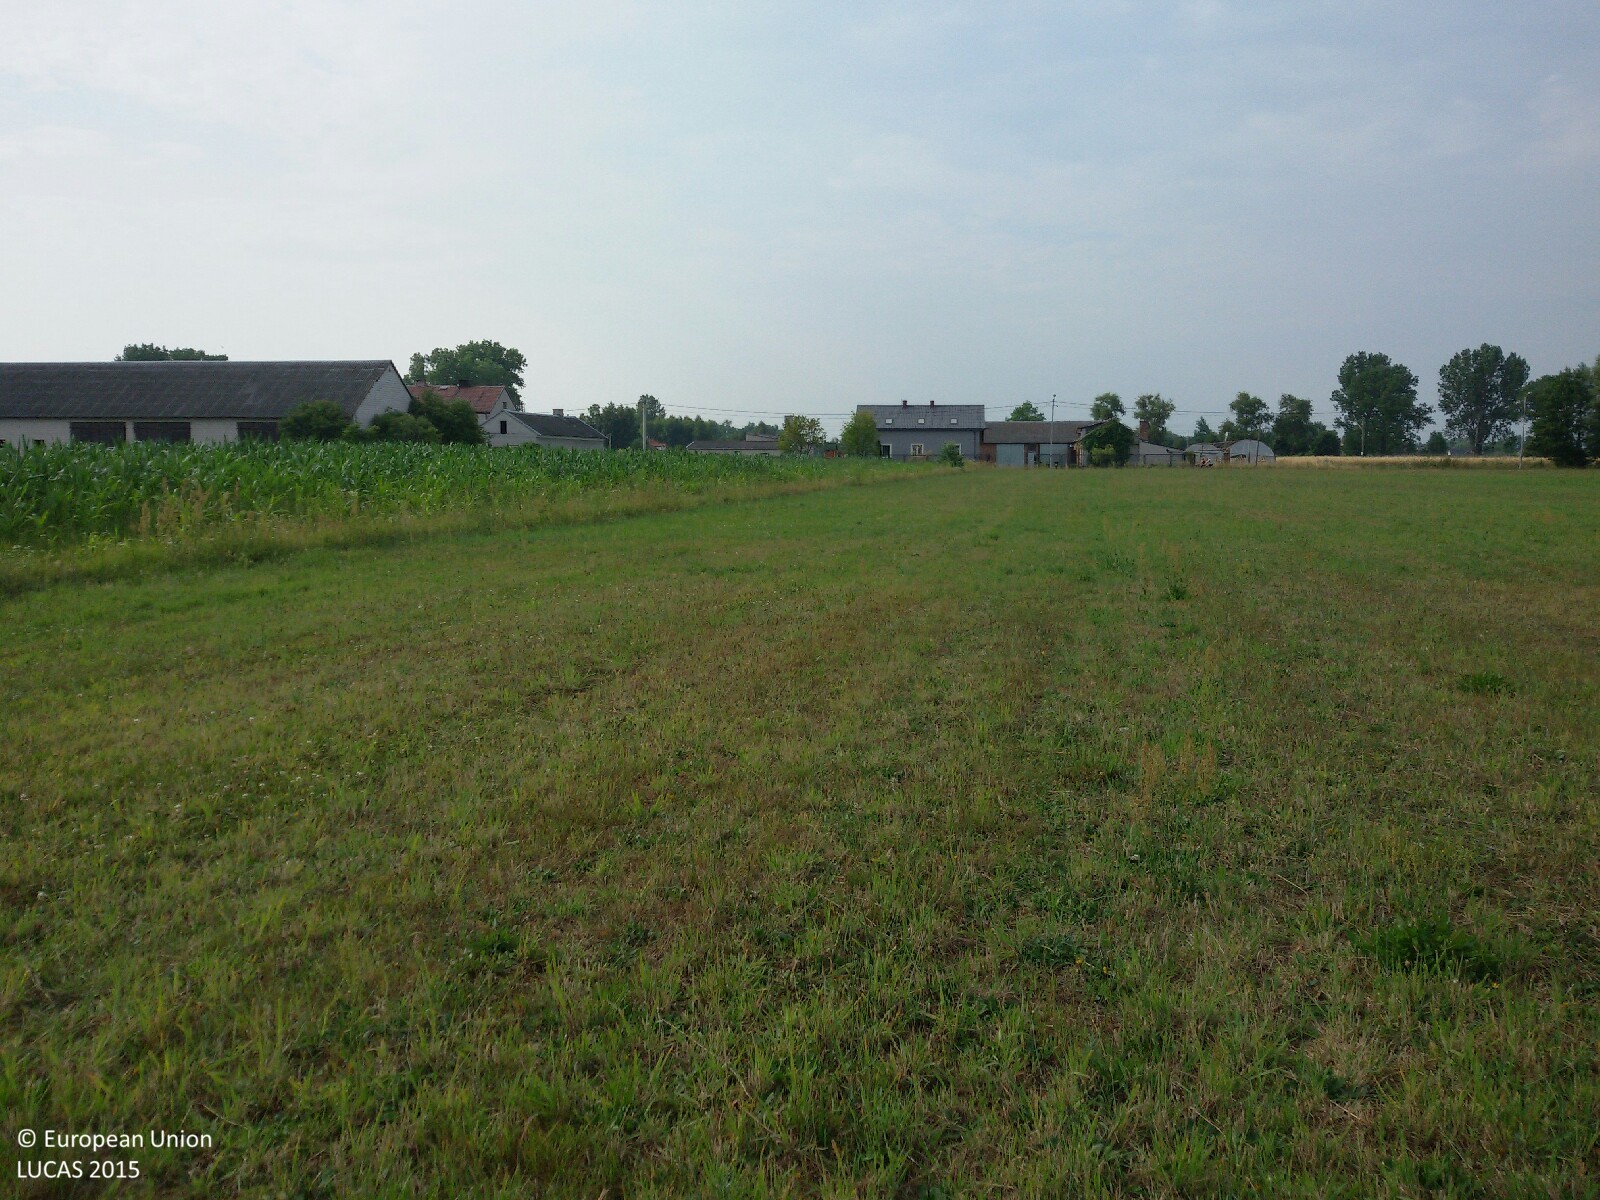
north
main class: Grassland
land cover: Grassland without tree/shrub cover
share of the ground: > 75 %
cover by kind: herbaceous plants 100 %
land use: Agriculture (excluding fallow land and kitchen gardens)
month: July
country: PL
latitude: 52.4258
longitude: 21.2088
